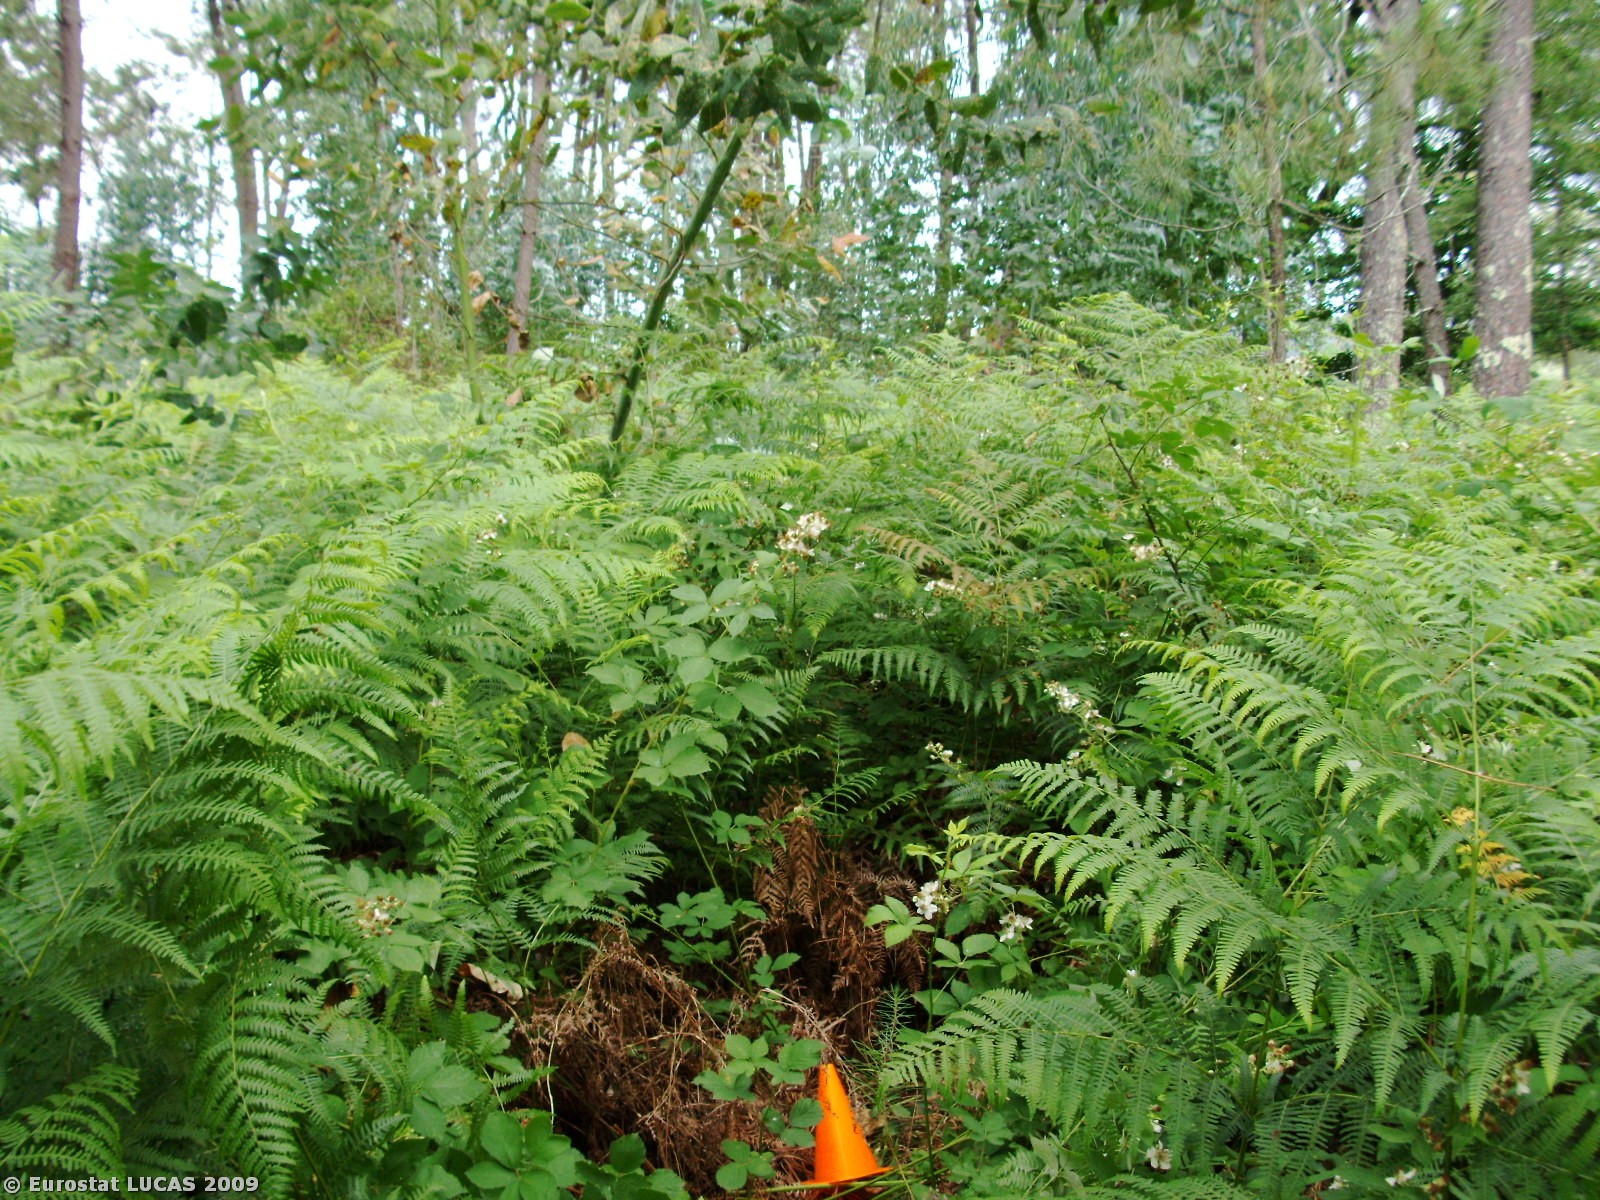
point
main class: Woodland
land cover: Mixed woodland
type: coniferous forest of the mediterranean region
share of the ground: > 75 %
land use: Forestry
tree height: > 5 m
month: June
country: PT
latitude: 39.7651
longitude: -8.3180
